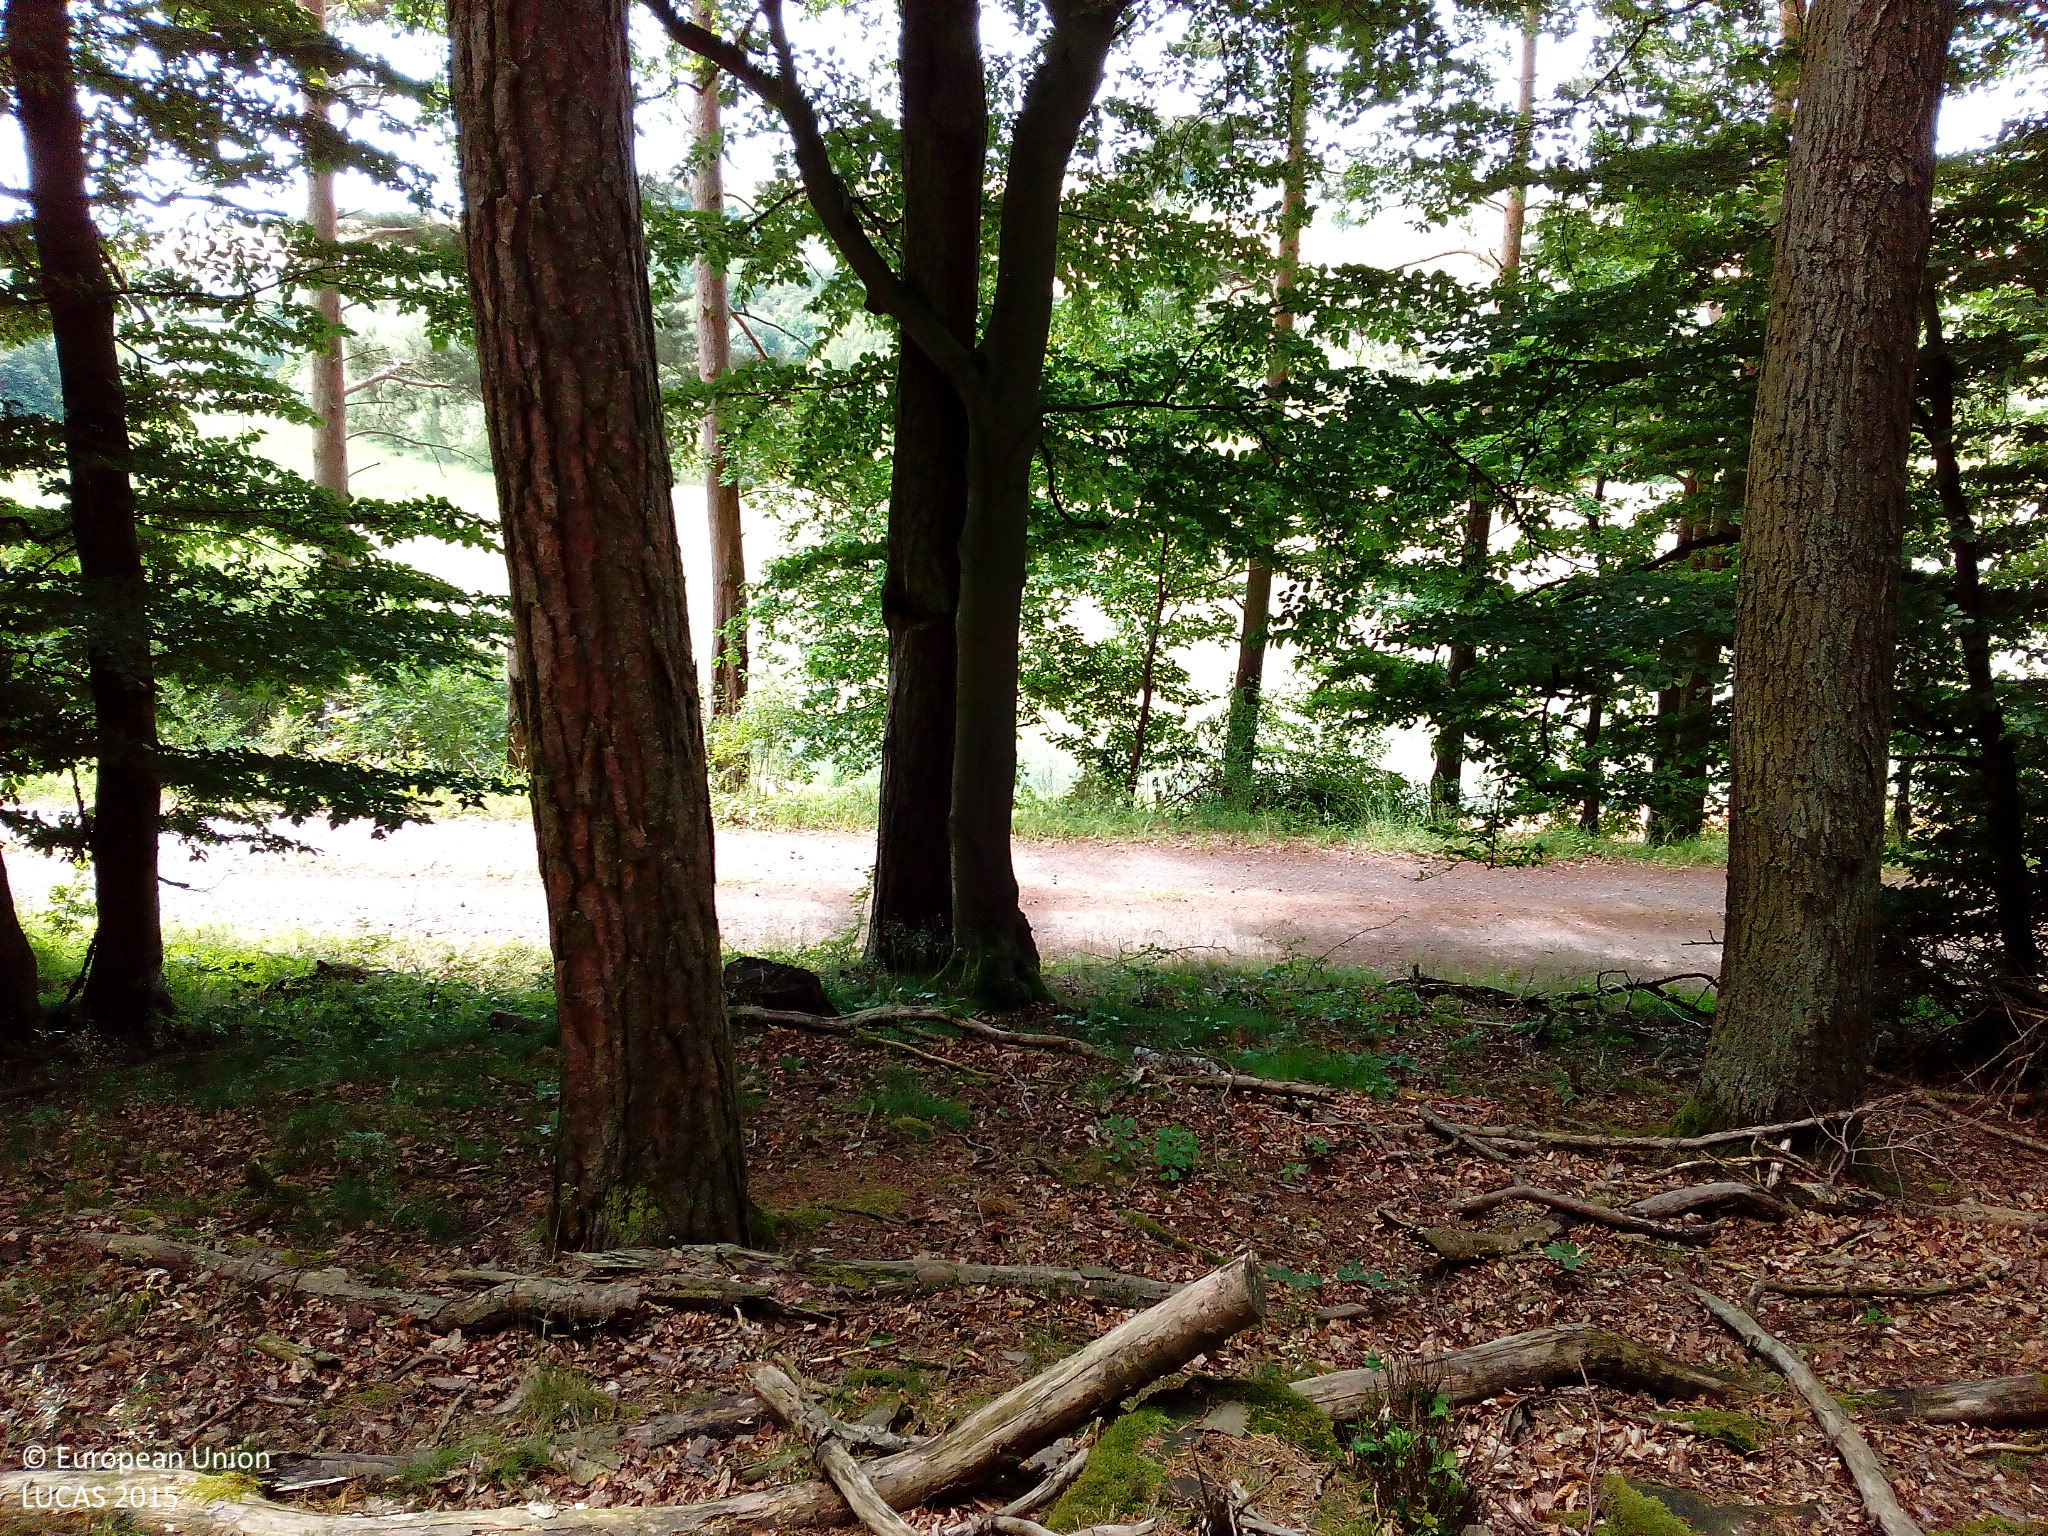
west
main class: Woodland
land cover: Pine dominated mixed woodland
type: hemiboreal forest and nemoral coniferous forest and mixed broadleaved-coniferous forest
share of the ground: > 75 %
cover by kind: broadleaved forest trees 50 %, coniferous forest trees 40 %, unconsolidated bare surface 10 %
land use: Forestry
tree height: > 5 m
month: June
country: DE
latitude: 51.1880
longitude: 9.1561
